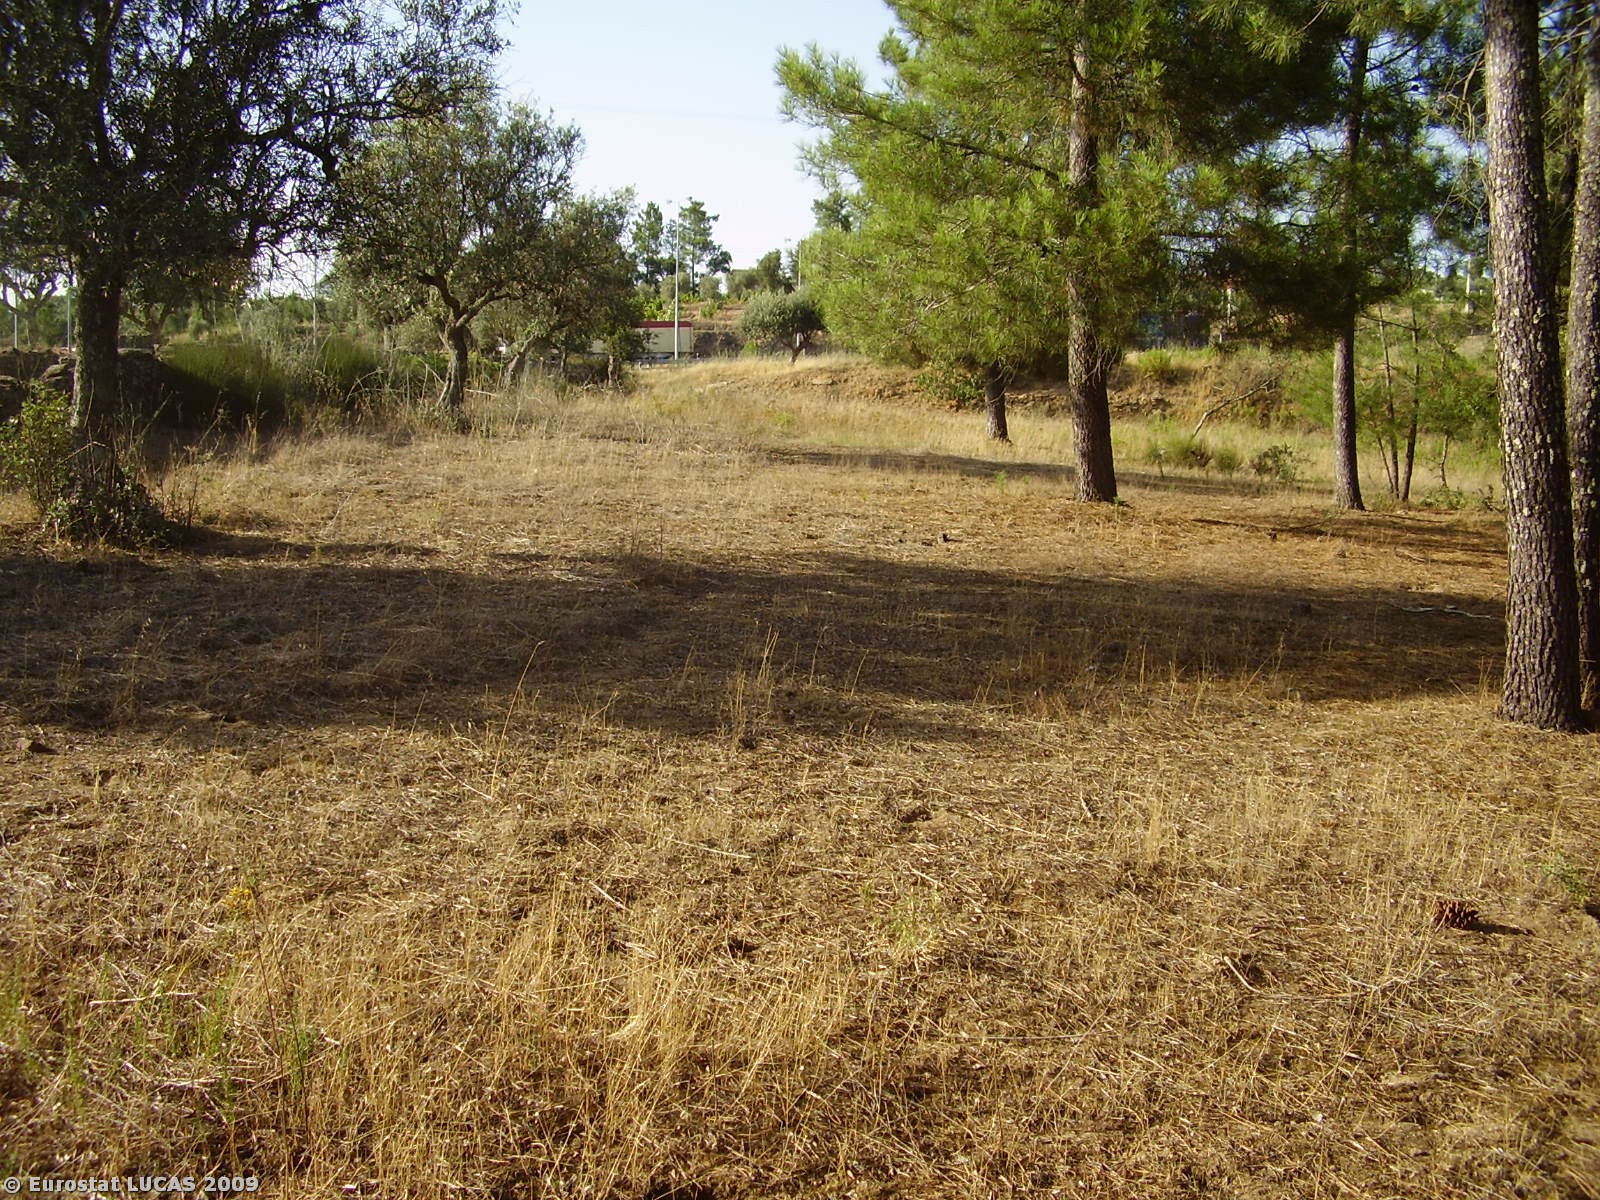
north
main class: Woodland
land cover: Coniferous woodland
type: coniferous forest of the mediterranean region
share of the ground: < 10 %
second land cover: Spontaneously vegetated surfaces
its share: > 75 %
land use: Forestry
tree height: > 5 m
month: July
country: PT
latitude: 39.4929
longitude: -8.0963
